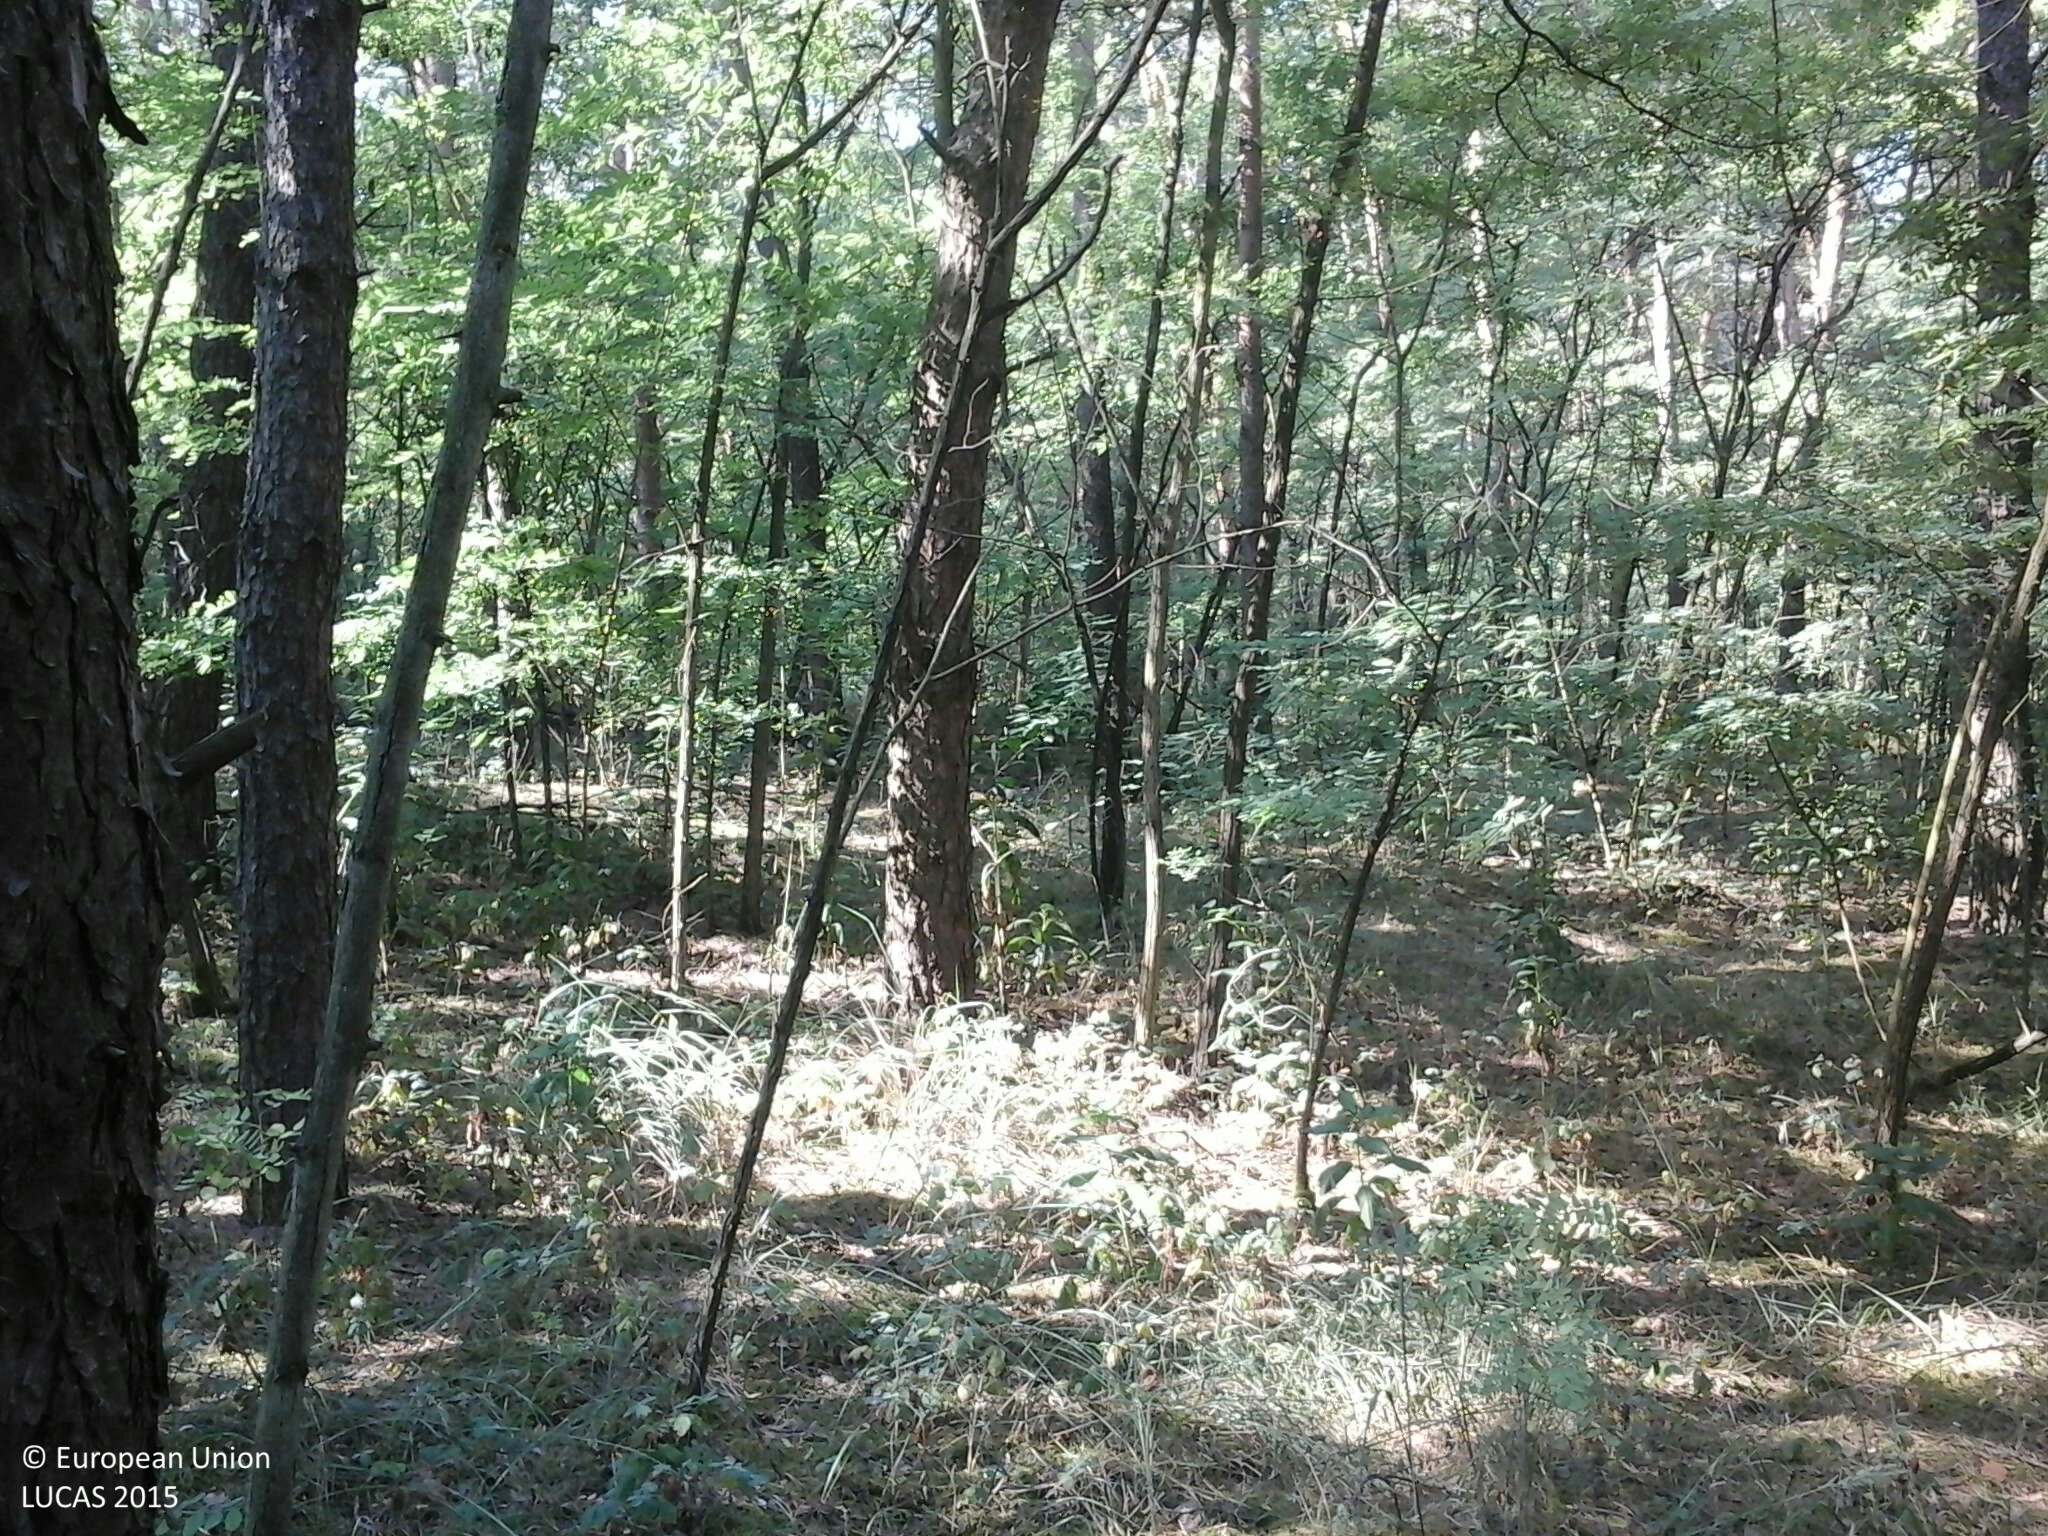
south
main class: Woodland
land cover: Pine dominated coniferous woodland
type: non-riverine alder, birch or aspen forest
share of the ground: 50 - 75 %
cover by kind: coniferous forest trees 75 %, broadleaved forest trees 20 %, herbaceous plants 5 %
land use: Forestry
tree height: > 5 m
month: July
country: HU
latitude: 47.9139
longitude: 21.9732
